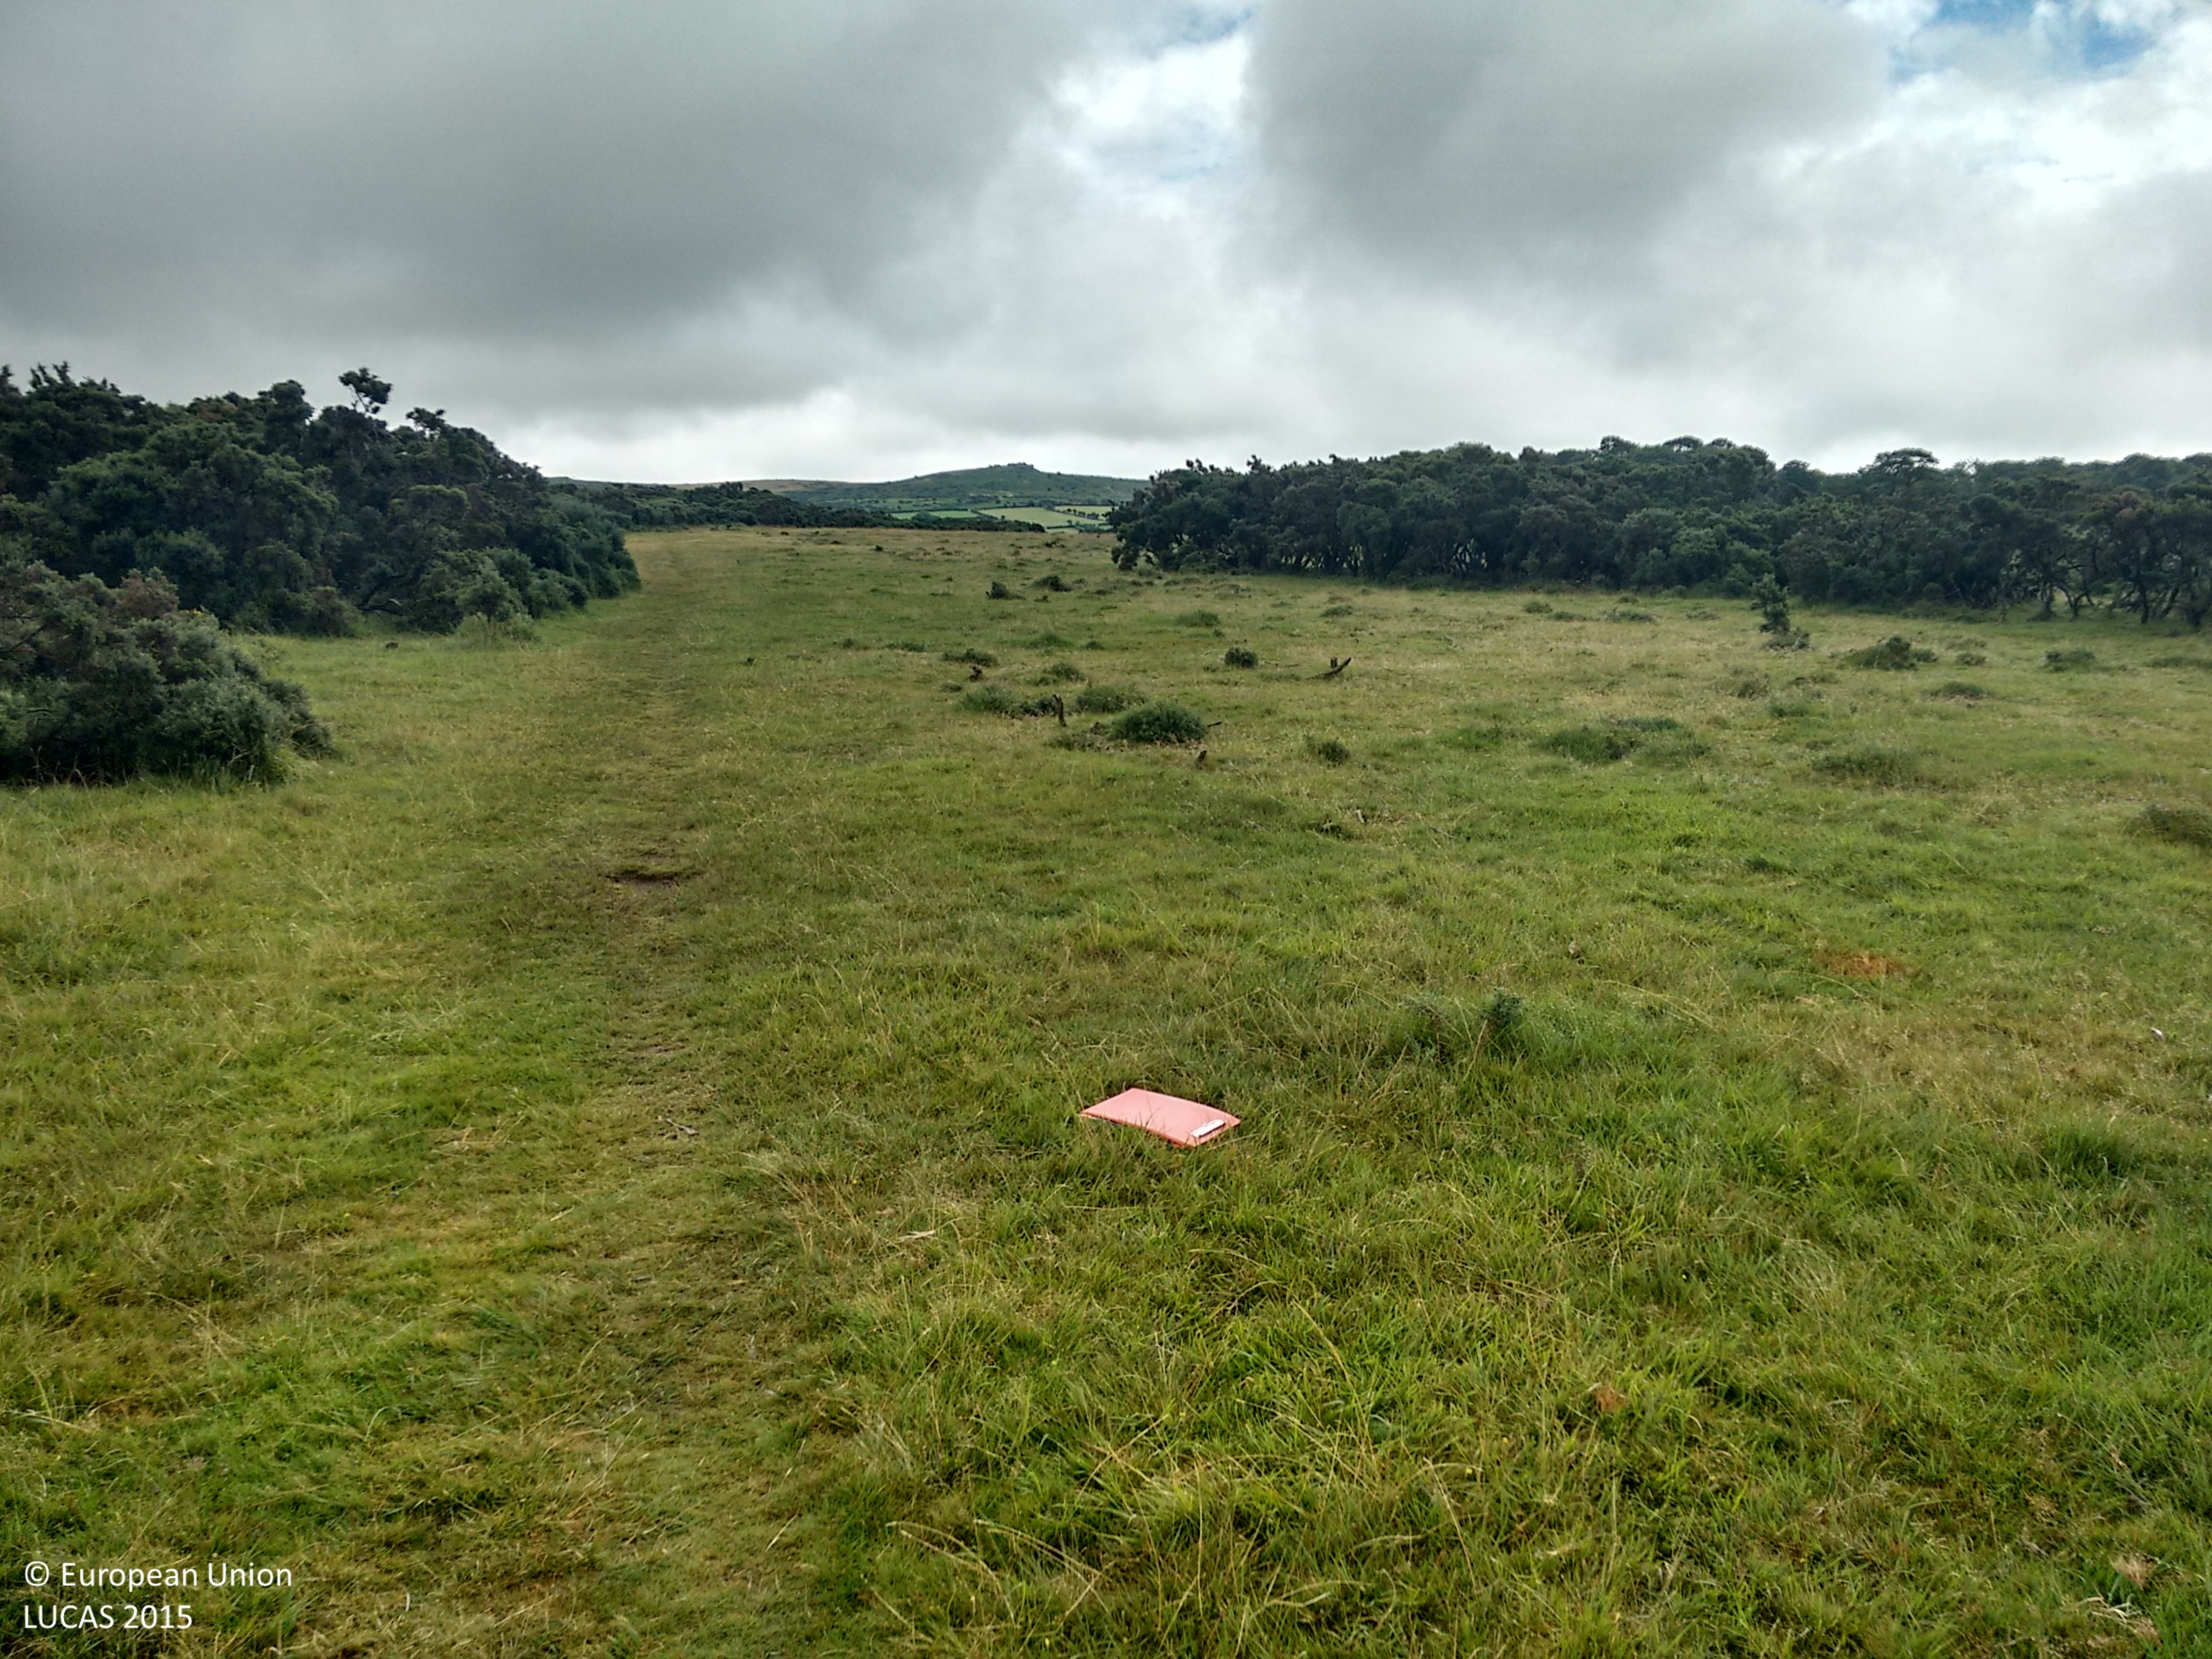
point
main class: Shrubland
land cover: Shrubland without tree cover
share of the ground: > 75 %
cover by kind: herbaceous plants 75 %, shrubs 25 %
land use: Agriculture (excluding fallow land and kitchen gardens)
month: August
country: GB
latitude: 50.5429
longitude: -4.1084
